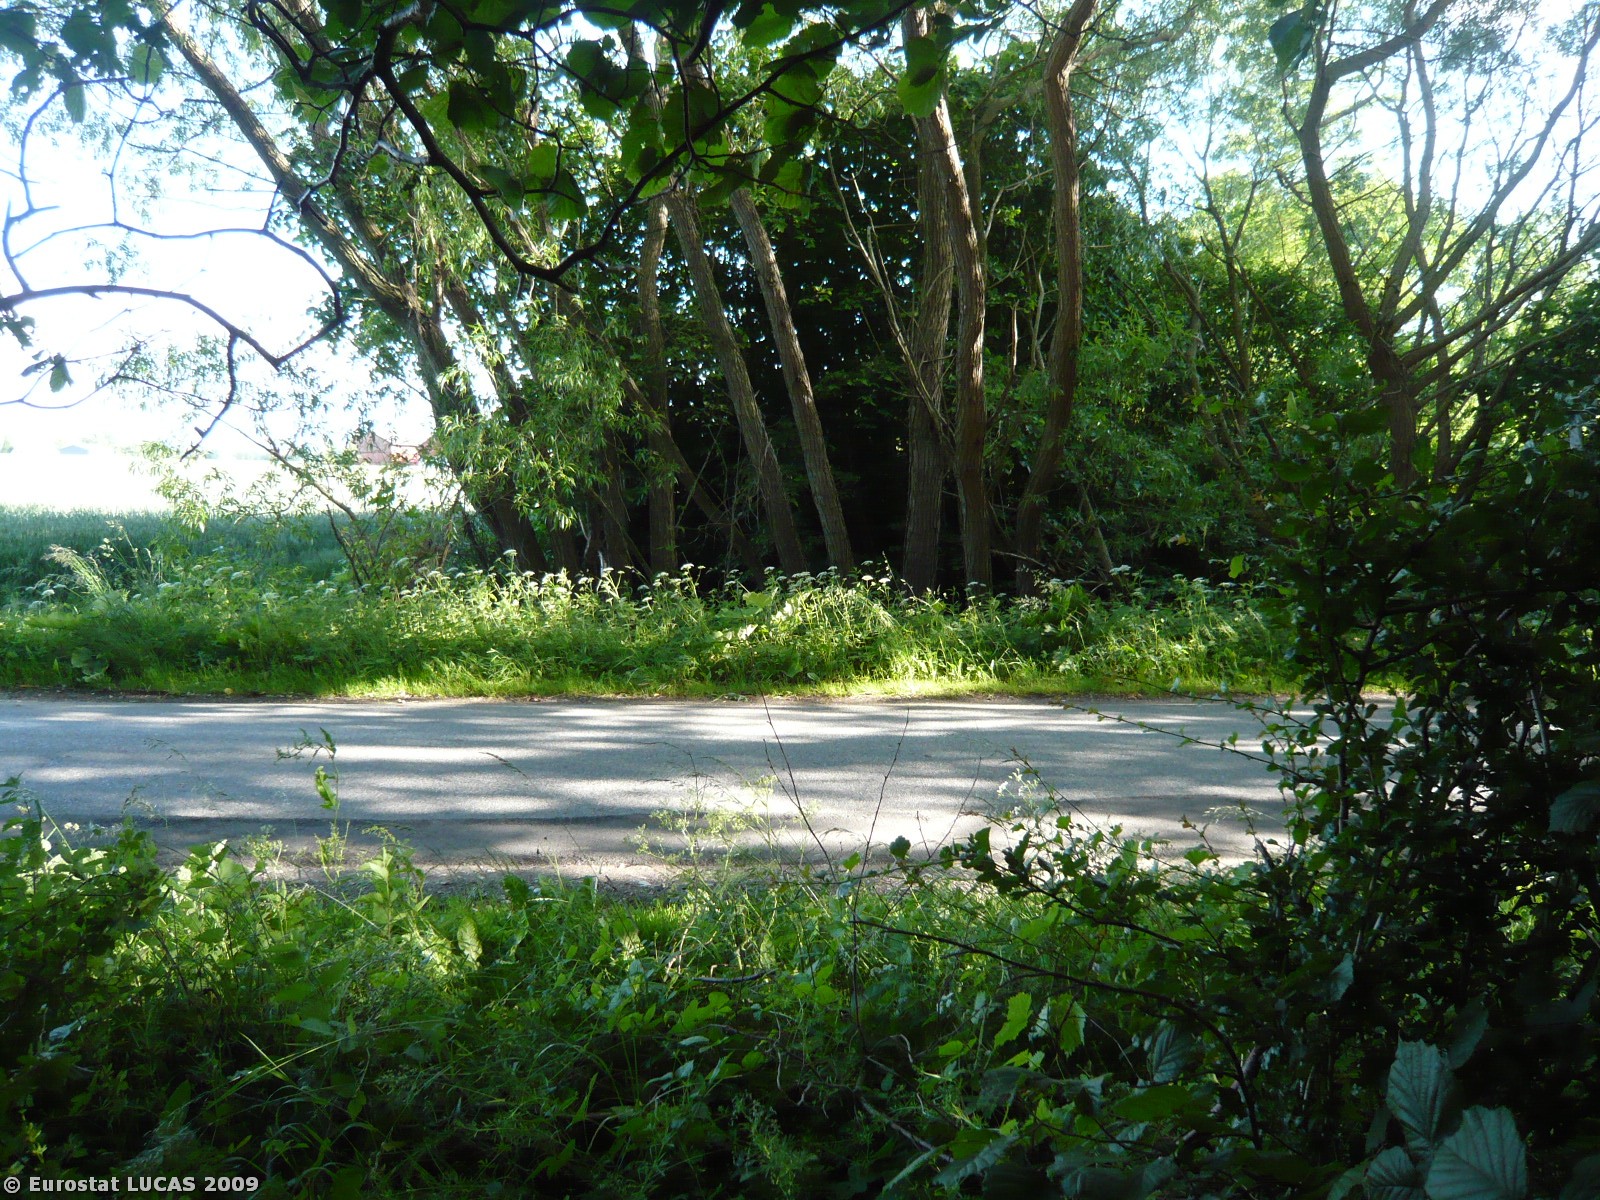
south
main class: Woodland
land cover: Broadleaved woodland
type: mesophytic deciduous forest
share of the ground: > 75 %
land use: Amenities, museums, leisure
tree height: > 5 m
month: June
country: DK
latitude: 54.8785
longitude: 11.9470
